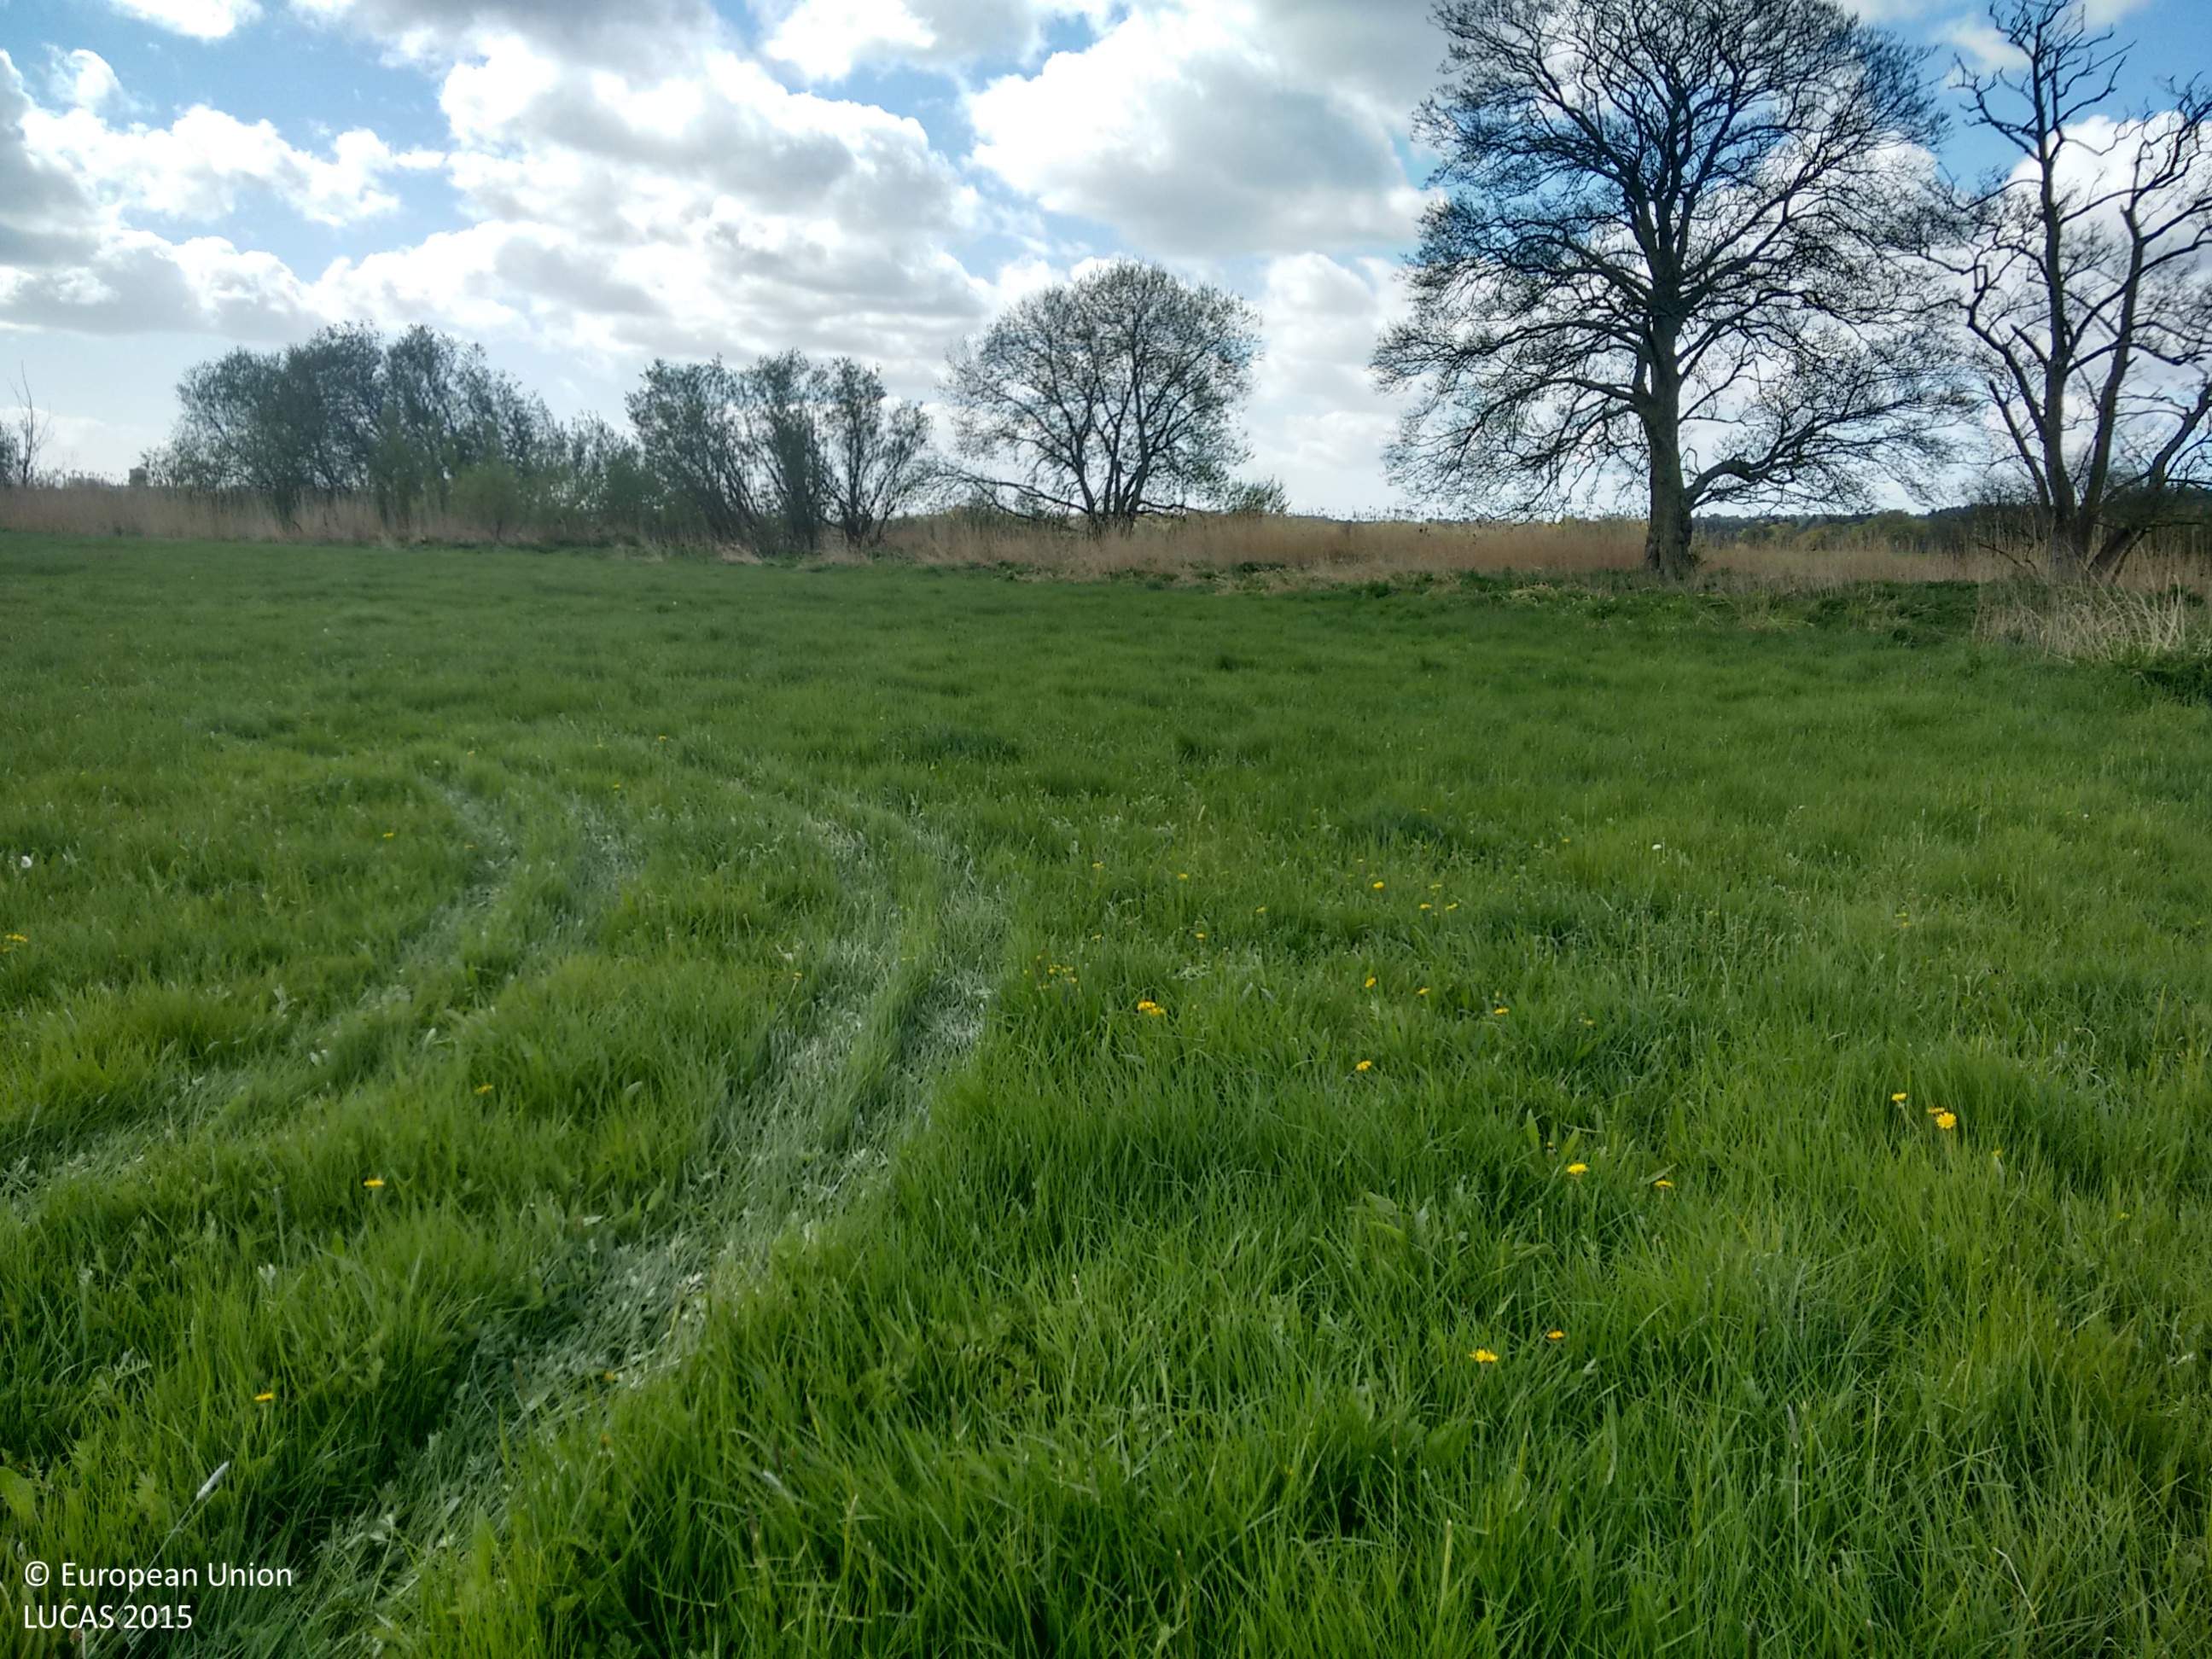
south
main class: Grassland
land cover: Grassland without tree/shrub cover
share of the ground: > 75 %
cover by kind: herbaceous plants 100 %
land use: Agriculture (excluding fallow land and kitchen gardens)
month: April
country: GB
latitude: 50.8591
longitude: -1.8042
